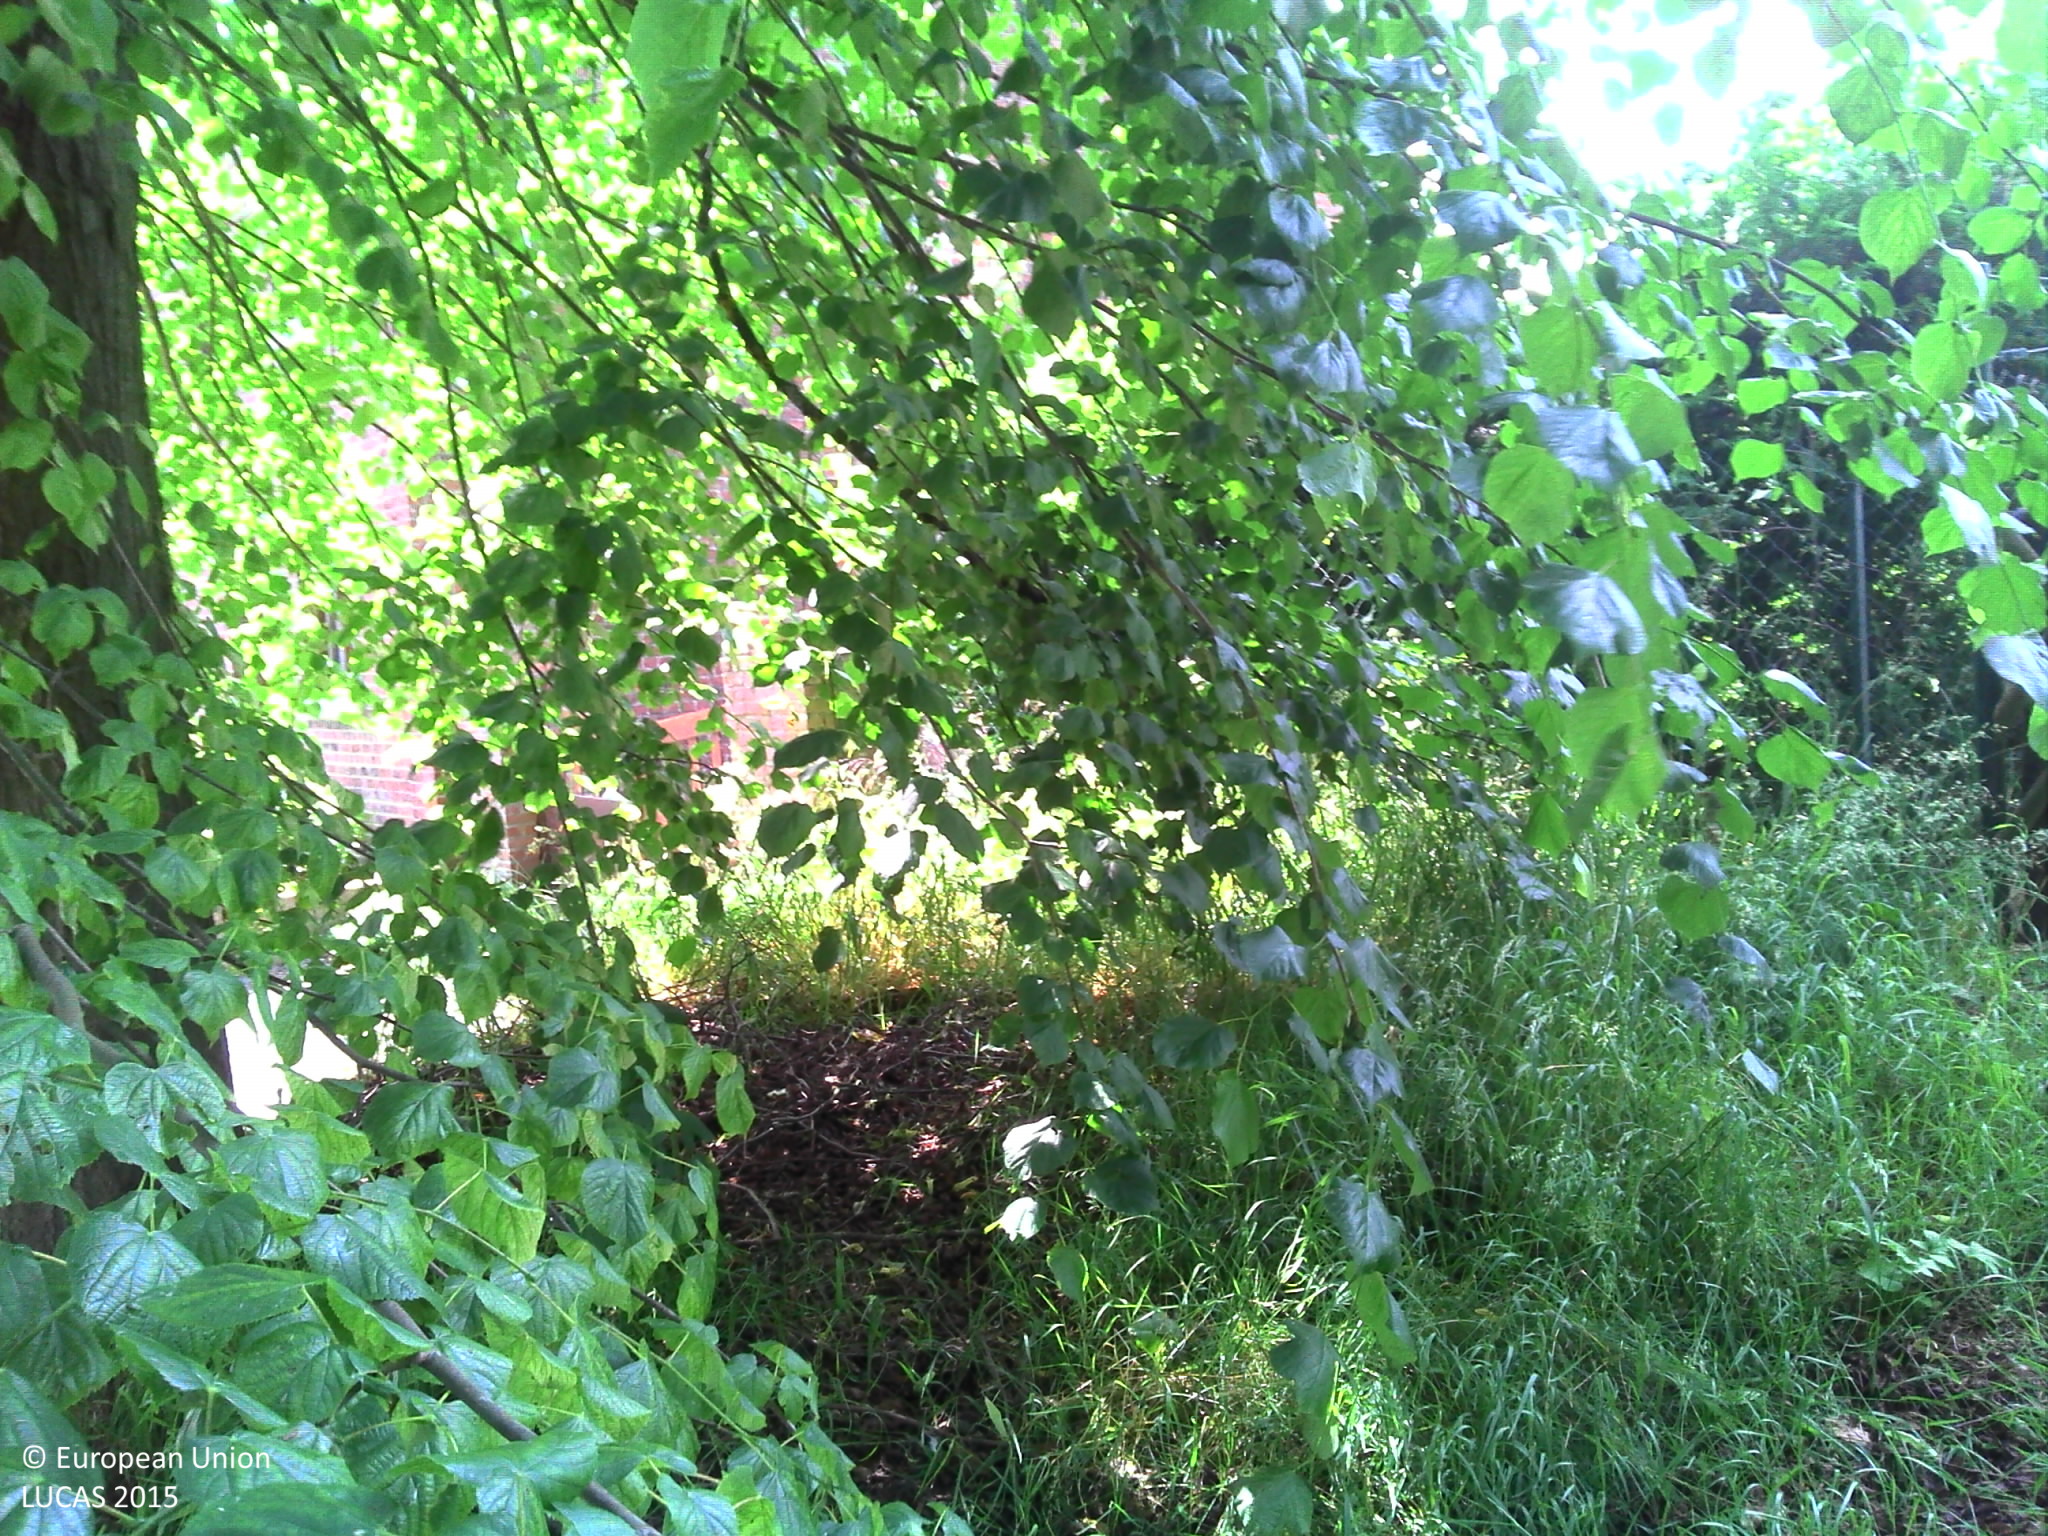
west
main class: Grassland
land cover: Grassland with sparse tree/shrub cover
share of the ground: 50 - 75 %
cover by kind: herbaceous plants 95 %, broadleaved forest trees 5 %
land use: Residential
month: June
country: BE
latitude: 50.3564
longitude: 3.7668
